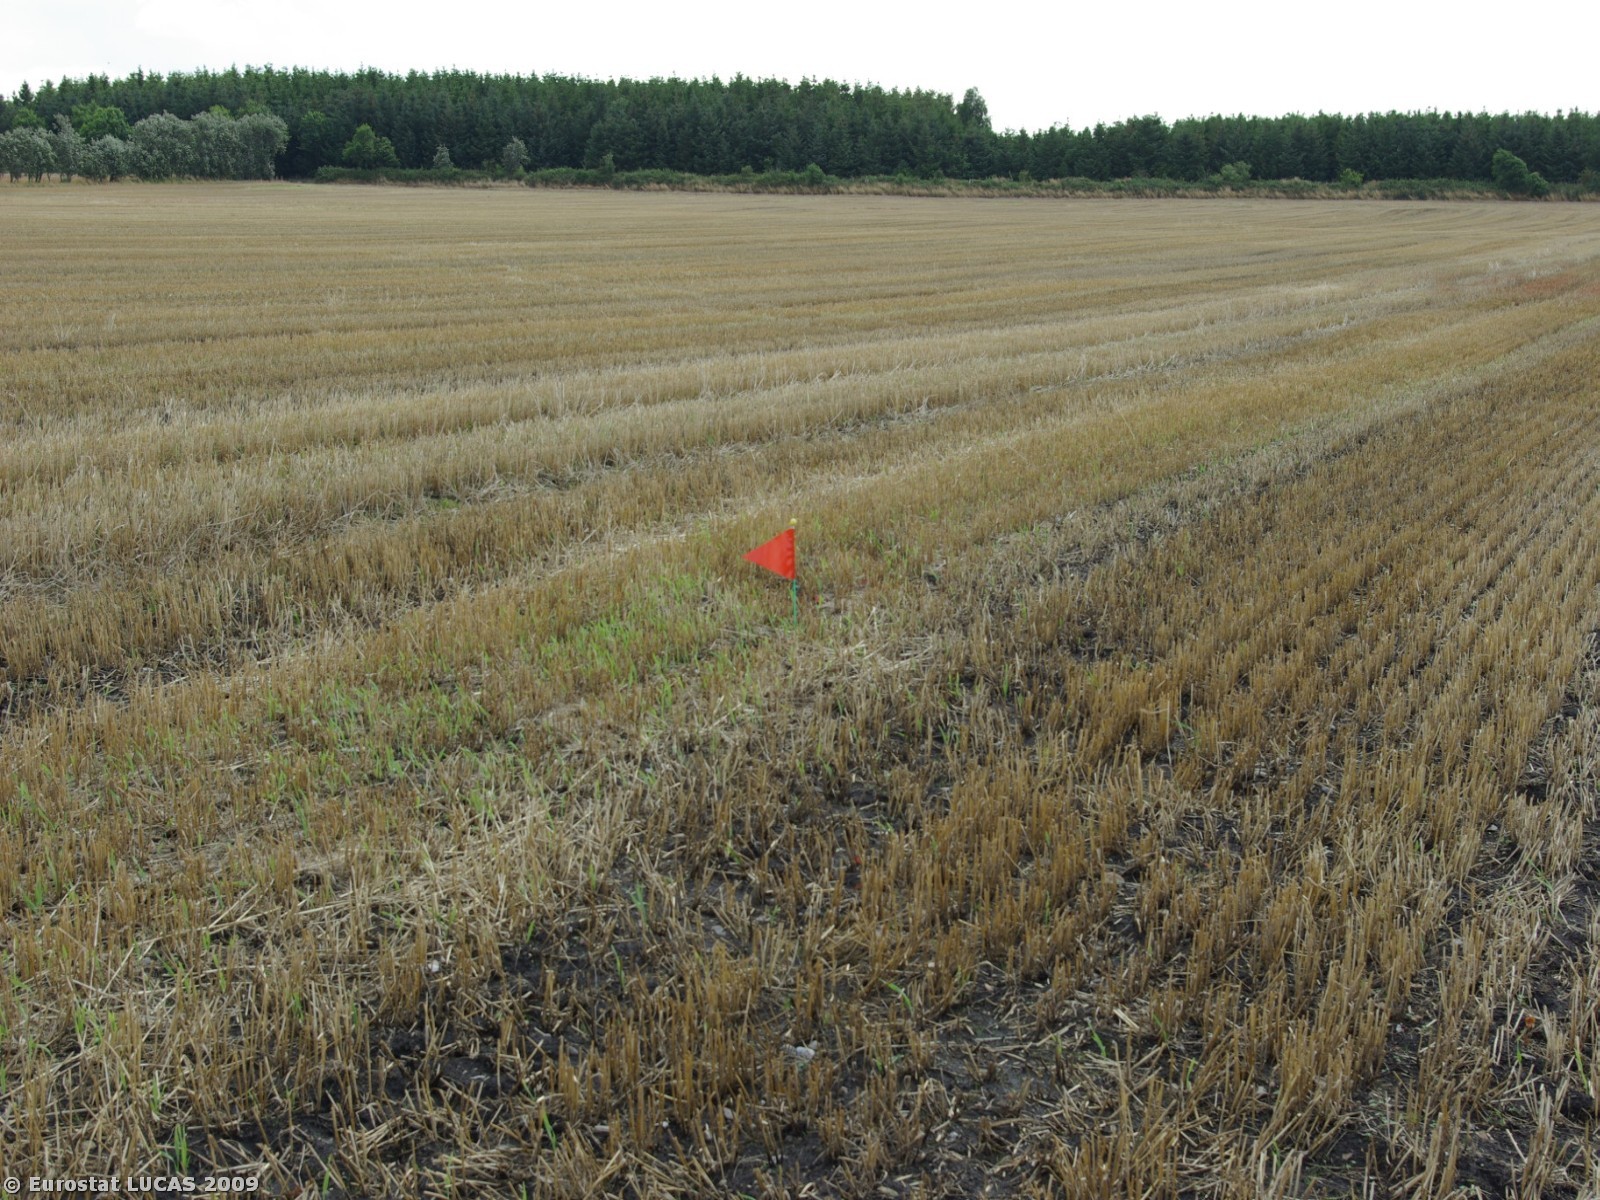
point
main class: Cropland
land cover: Barley
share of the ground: < 10 %
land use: Agriculture (excluding fallow land and kitchen gardens)
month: July
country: DK
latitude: 55.1433
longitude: 9.2946
